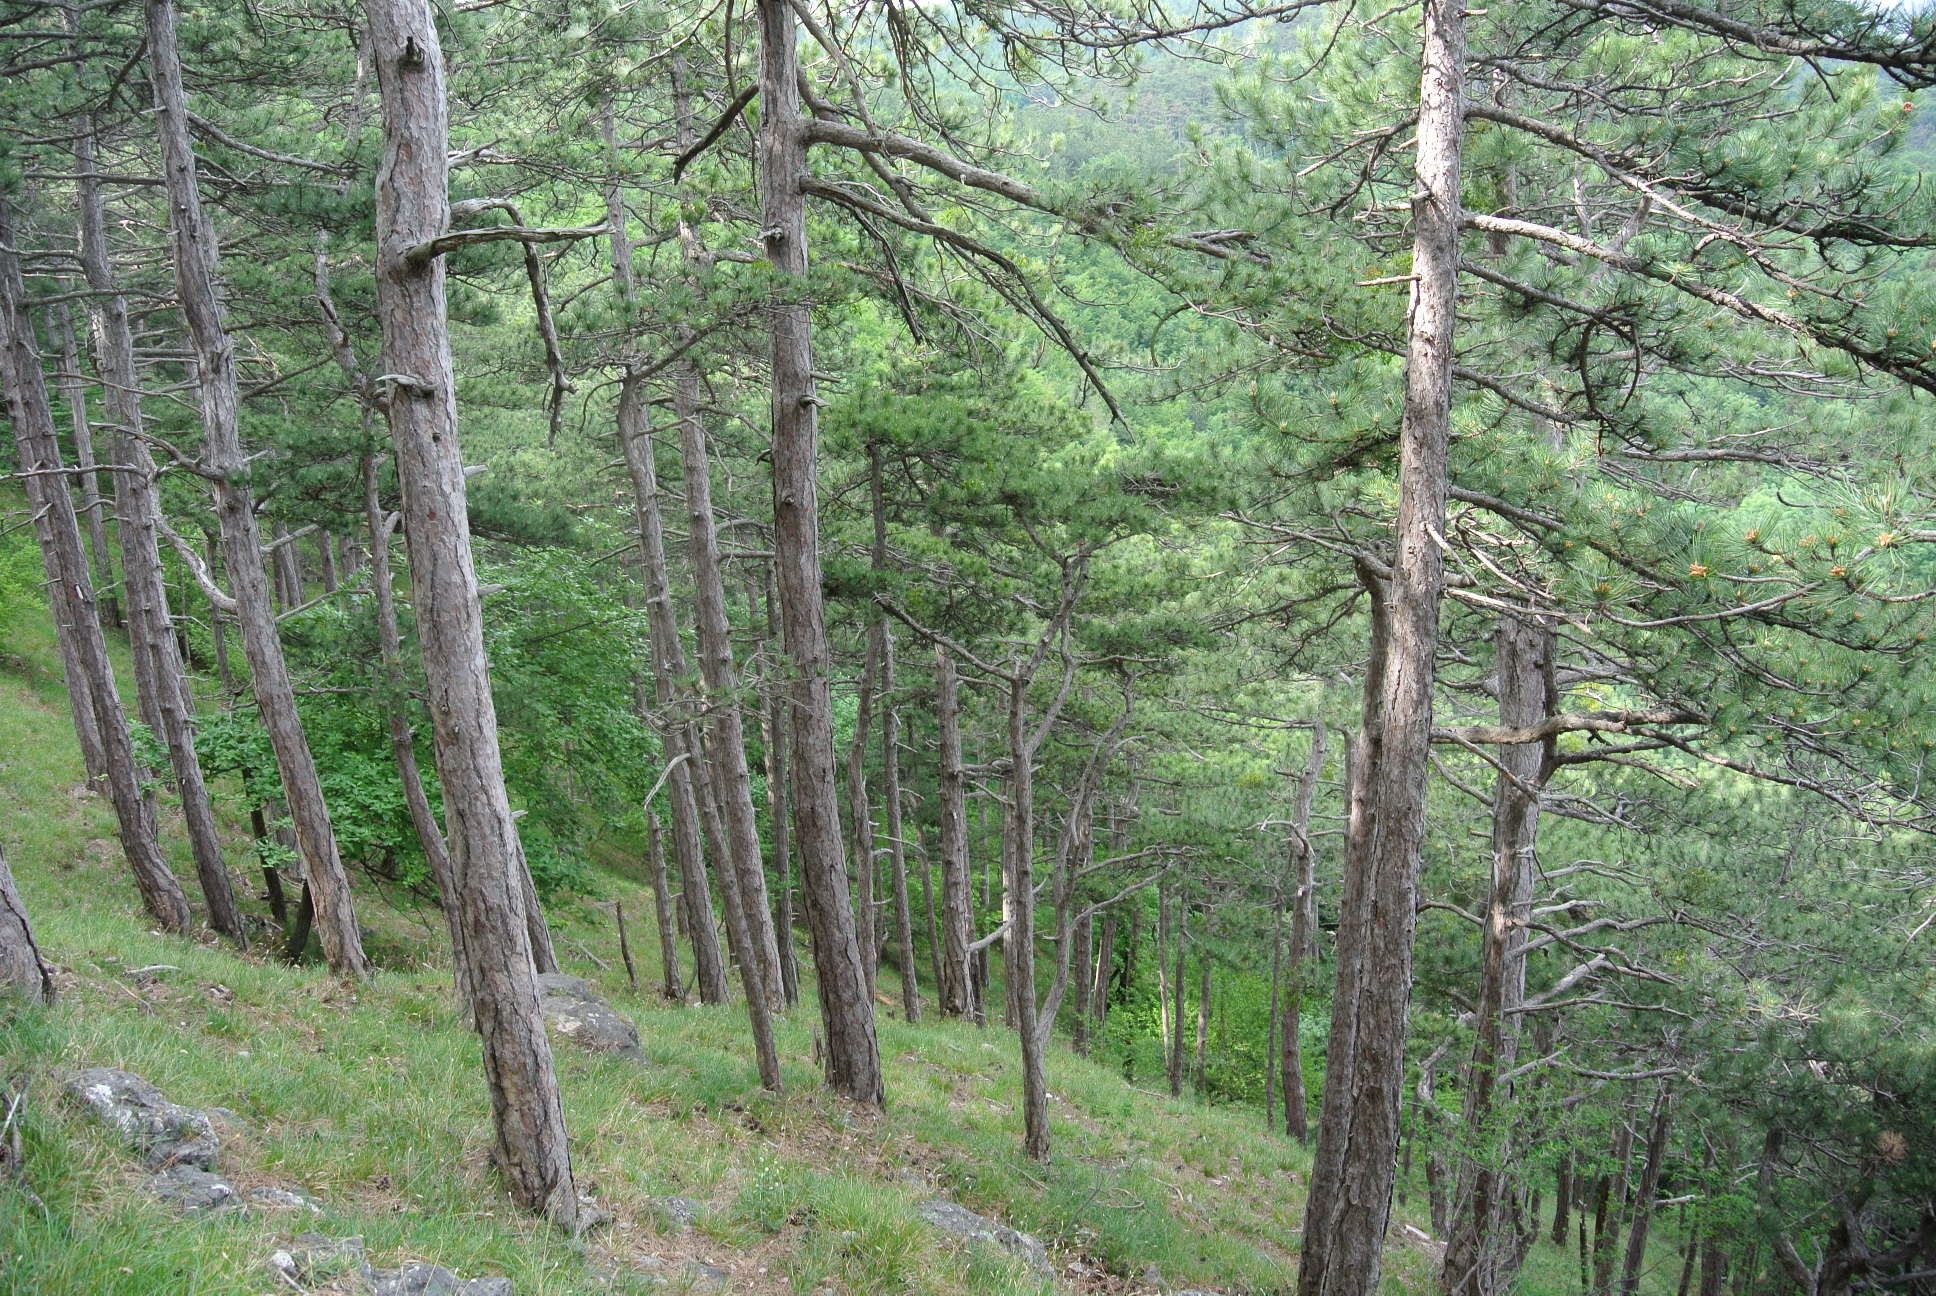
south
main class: Woodland
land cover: Pine dominated coniferous woodland
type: alpine coniferous forest
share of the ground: > 75 %
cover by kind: coniferous forest trees 85 %, herbaceous plants 10 %, unconsolidated bare surface 5 %
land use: Forestry
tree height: > 5 m
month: May
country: AT
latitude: 47.8540
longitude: 16.1380
